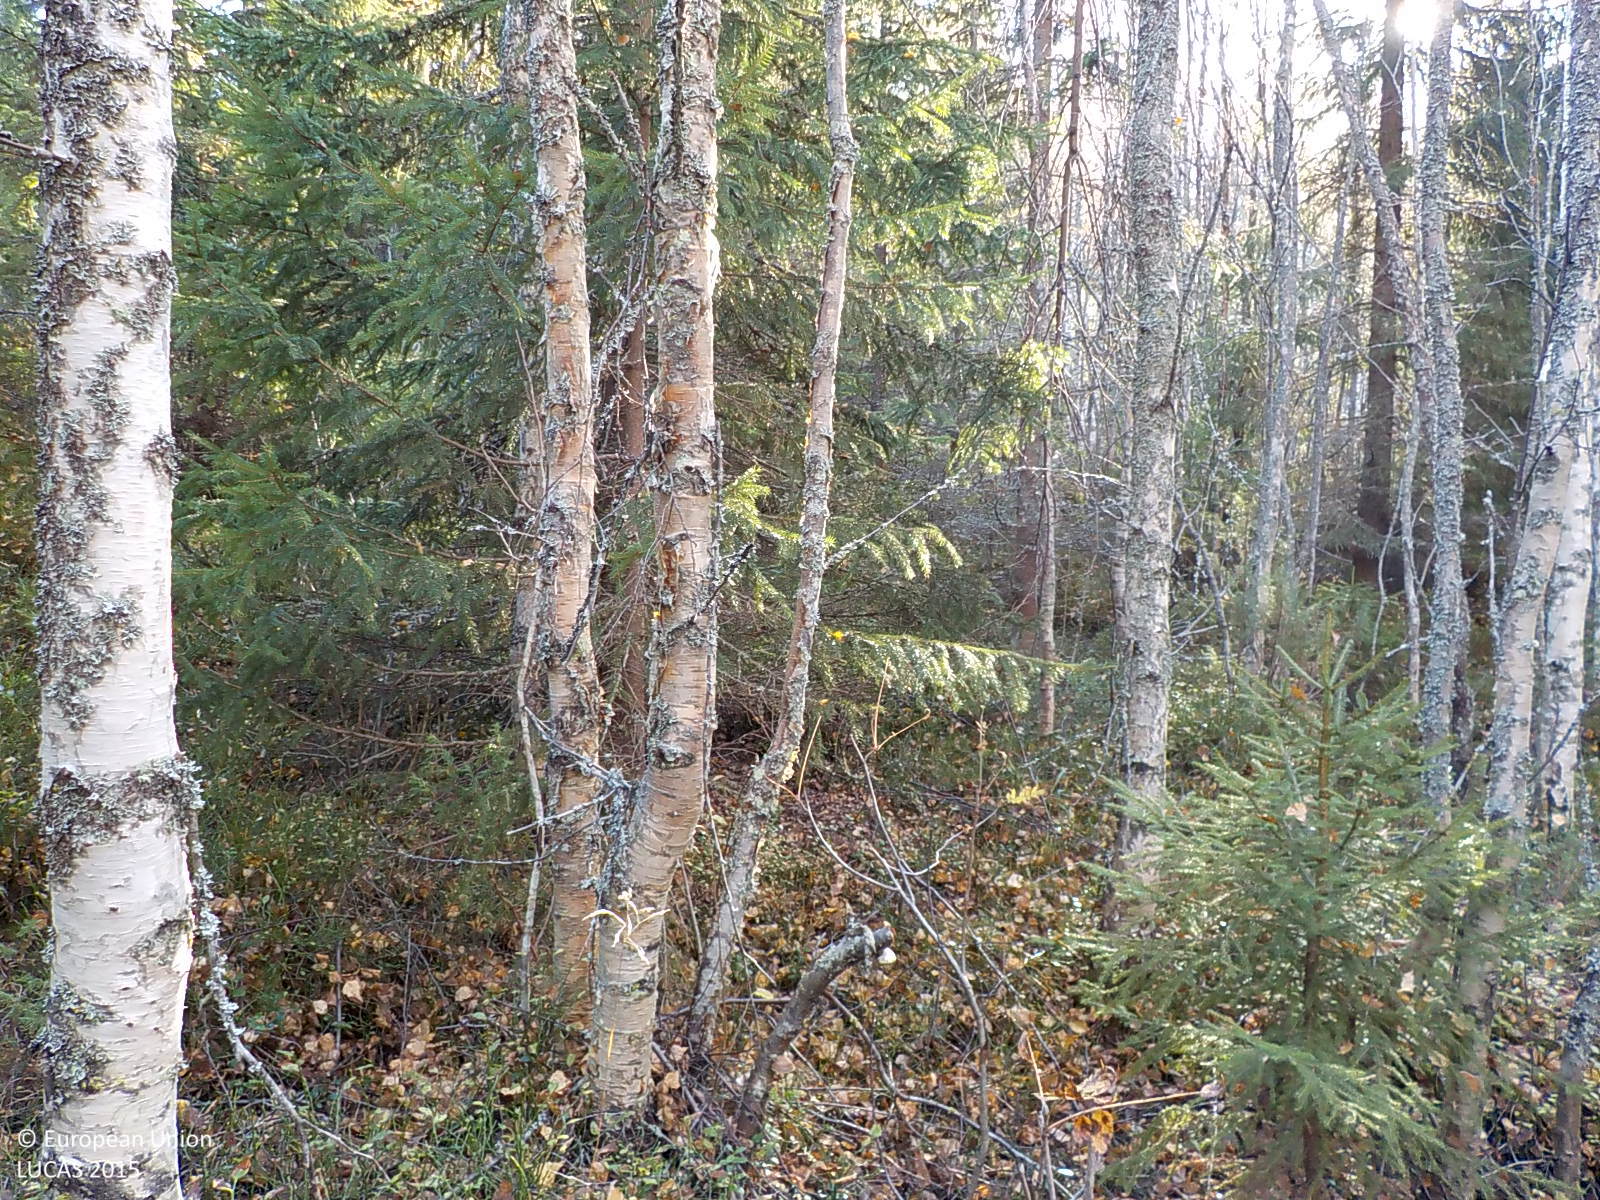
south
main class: Woodland
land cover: Broadleaved woodland
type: hemiboreal forest and nemoral coniferous forest and mixed broadleaved-coniferous forest
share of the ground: 50 - 75 %
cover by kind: broadleaved forest trees 60 %, shrubs 20 %, coniferous forest trees 10 %, lichens and mosses 10 %
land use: Forestry
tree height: > 5 m
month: October
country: SE
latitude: 62.9828
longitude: 18.2862
